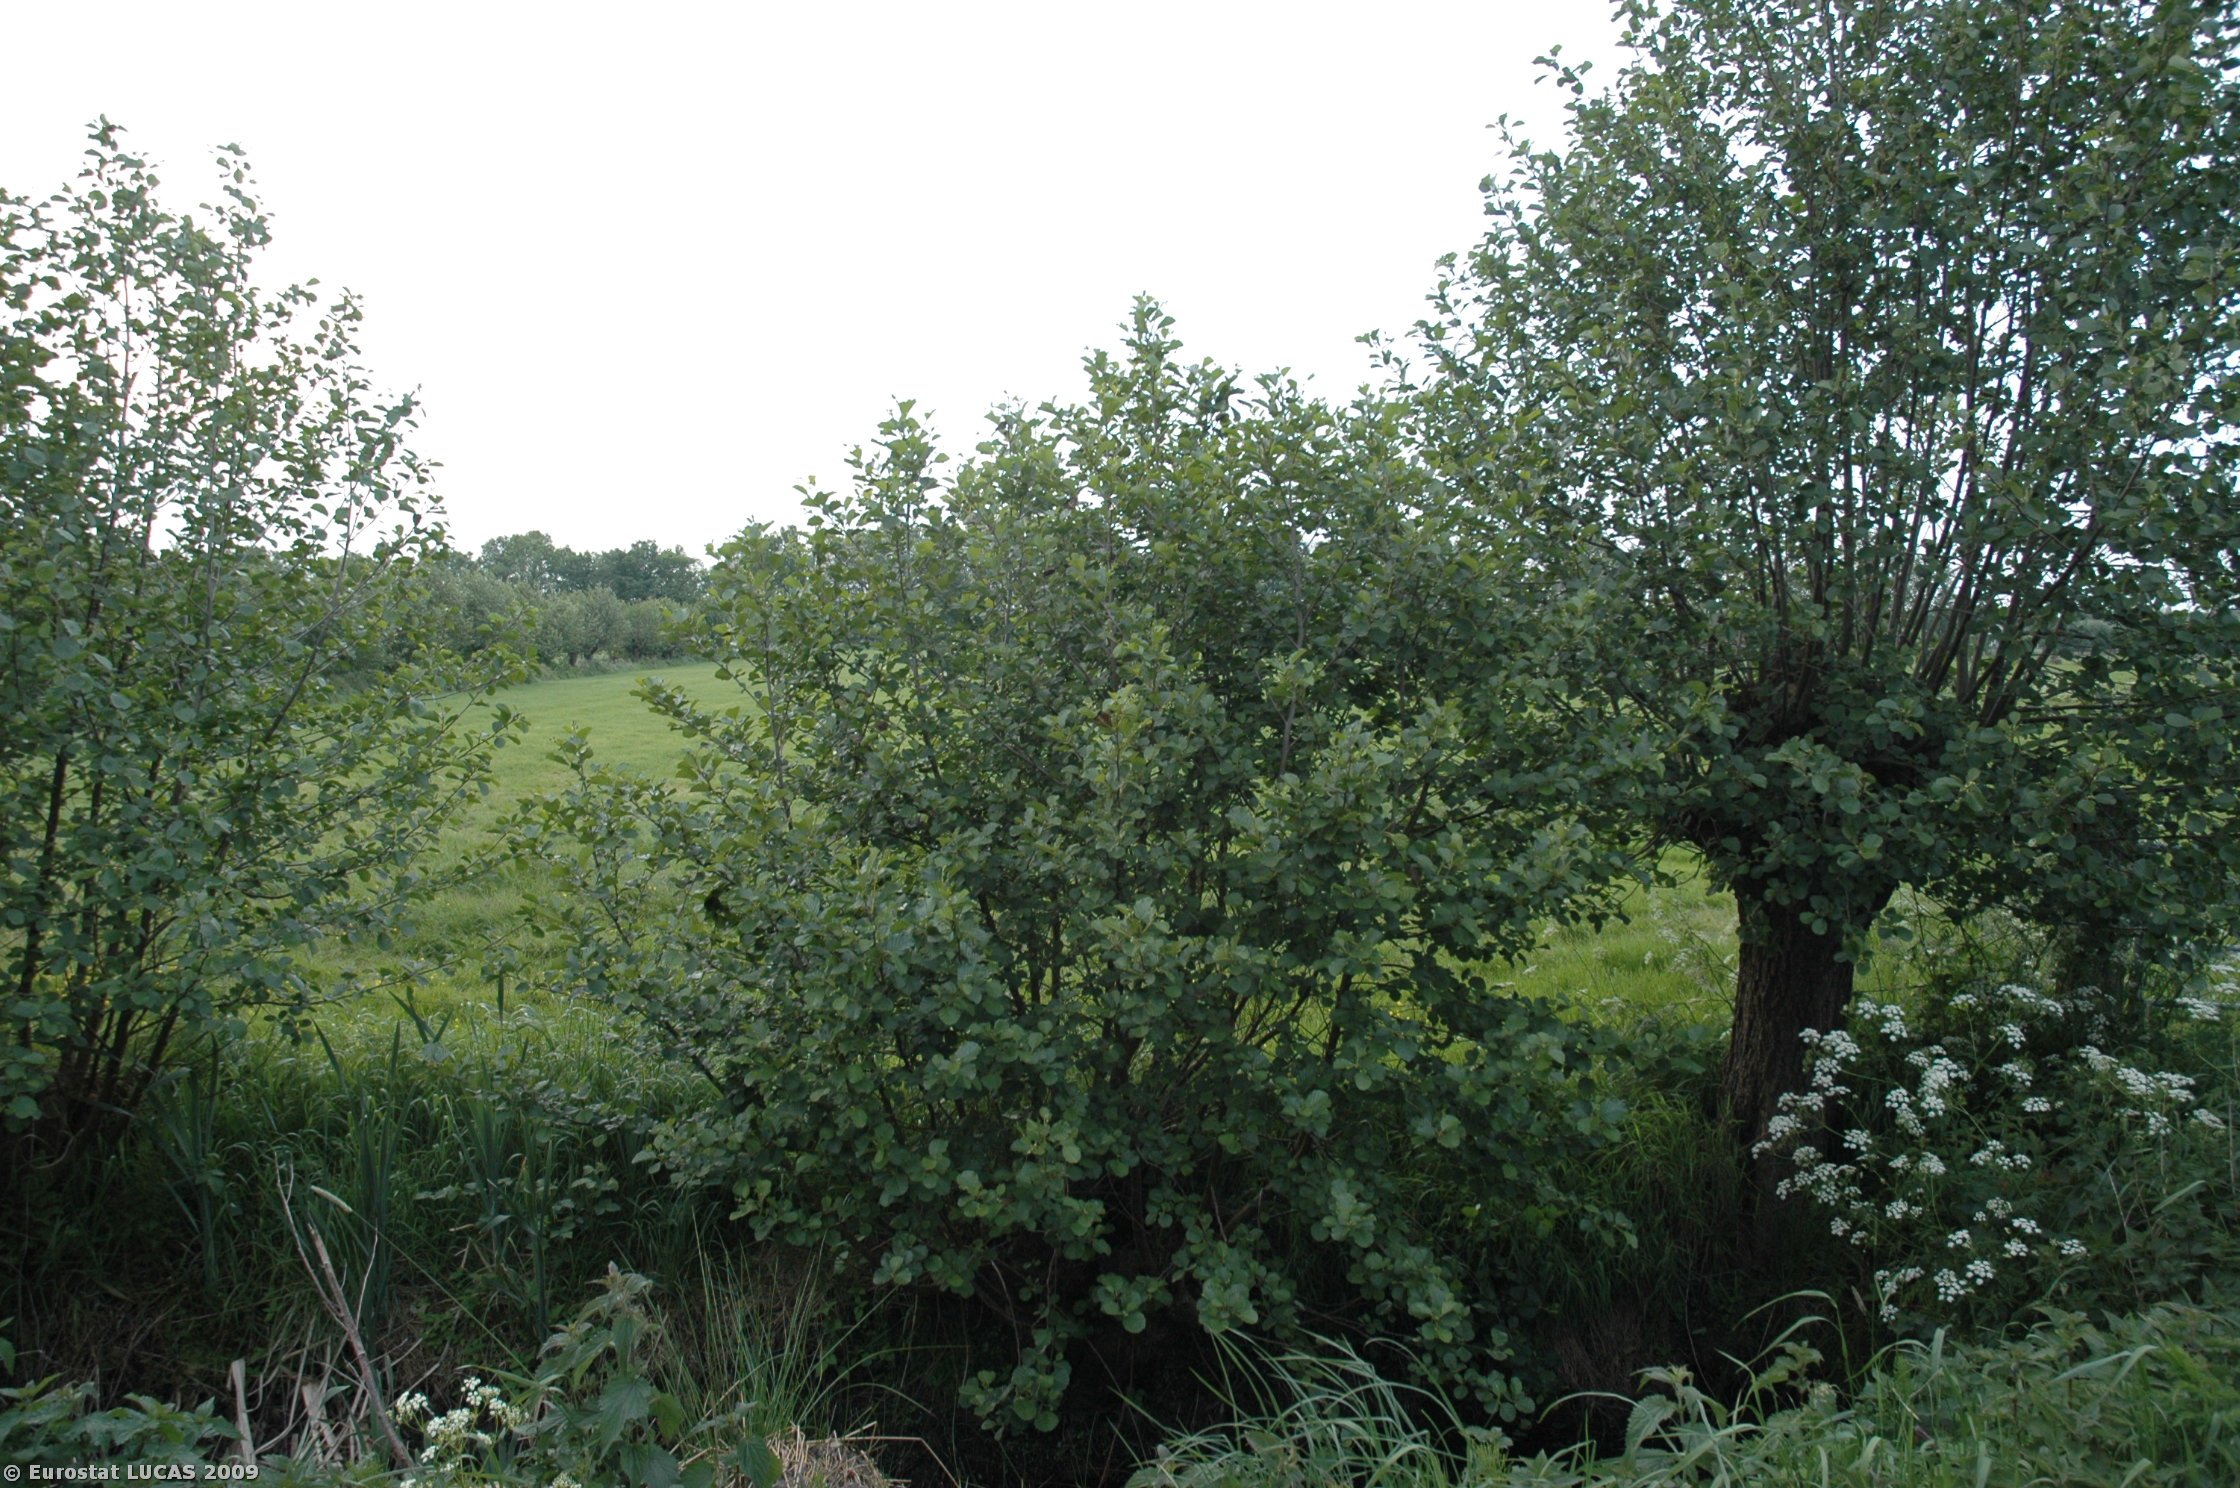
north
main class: Grassland
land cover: Grassland without tree/shrub cover
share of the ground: > 75 %
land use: Agriculture (excluding fallow land and kitchen gardens)
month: May
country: NL
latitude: 52.0724
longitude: 5.4024
